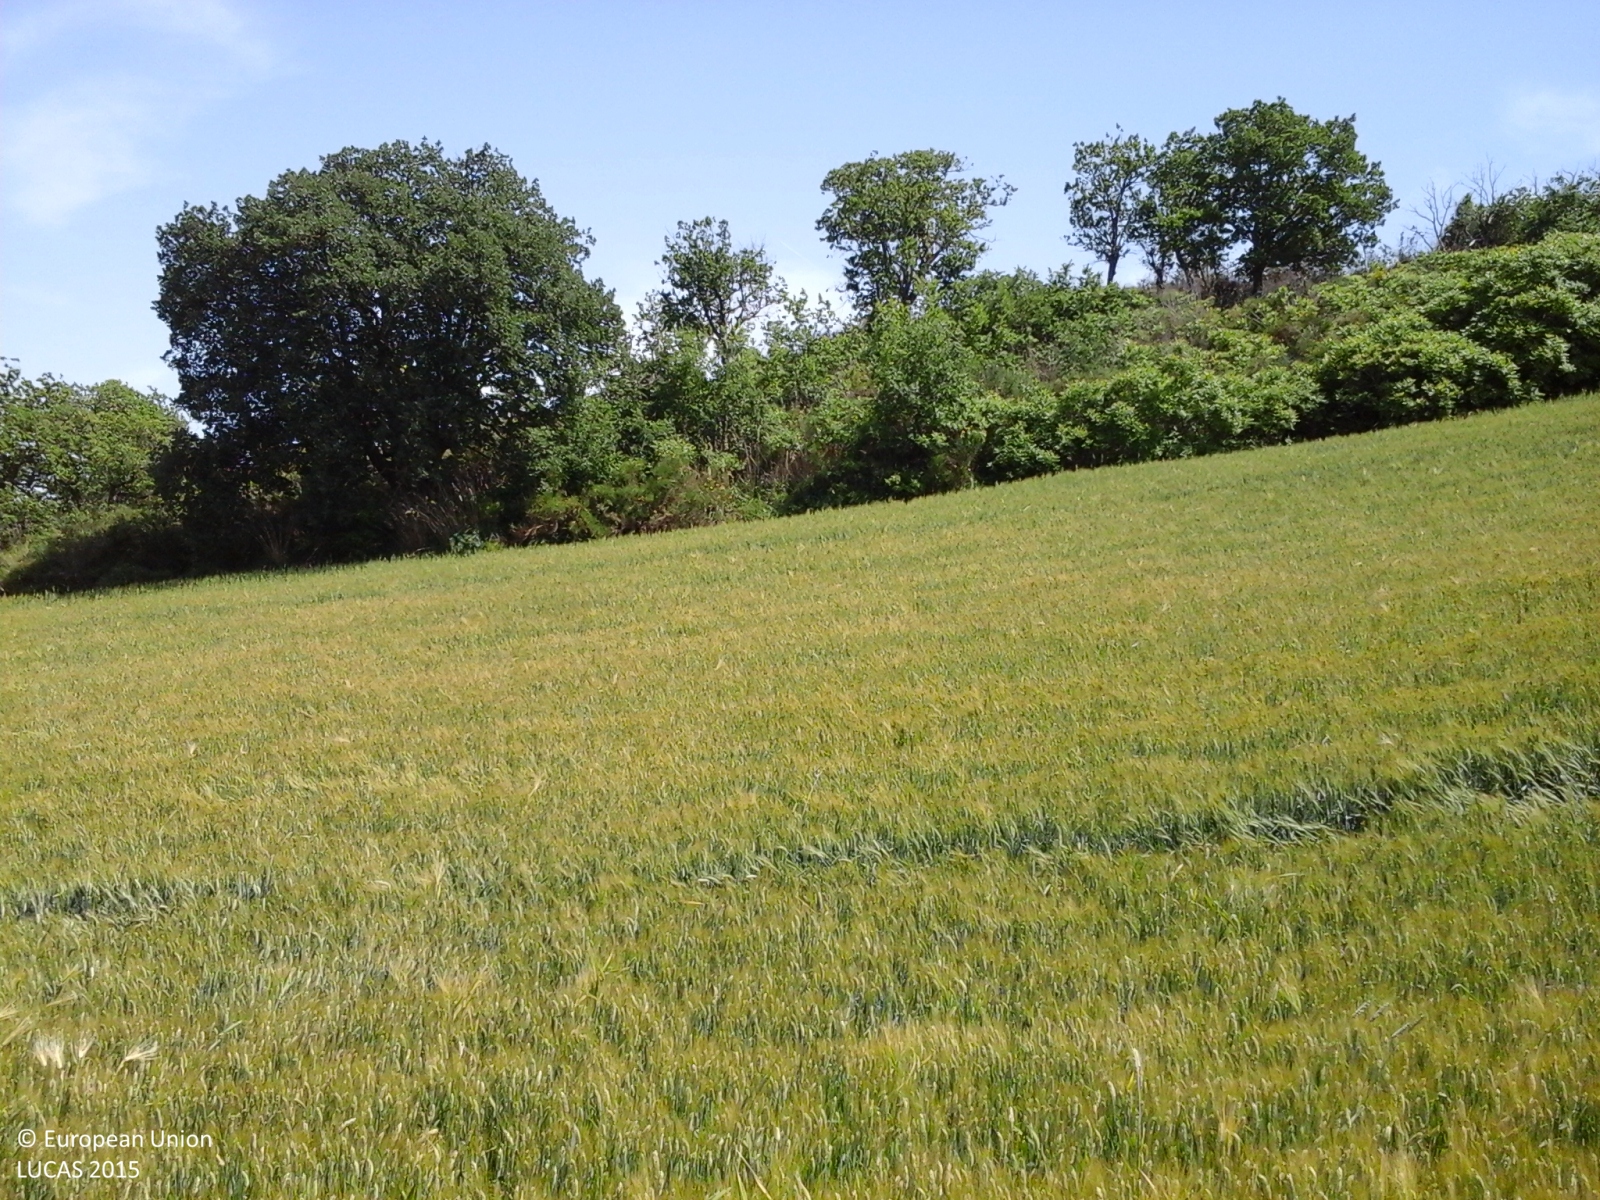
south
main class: Cropland
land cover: Durum wheat
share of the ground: > 75 %
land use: Agriculture (excluding fallow land and kitchen gardens)
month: May
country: IT
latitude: 37.8809
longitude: 13.5558
